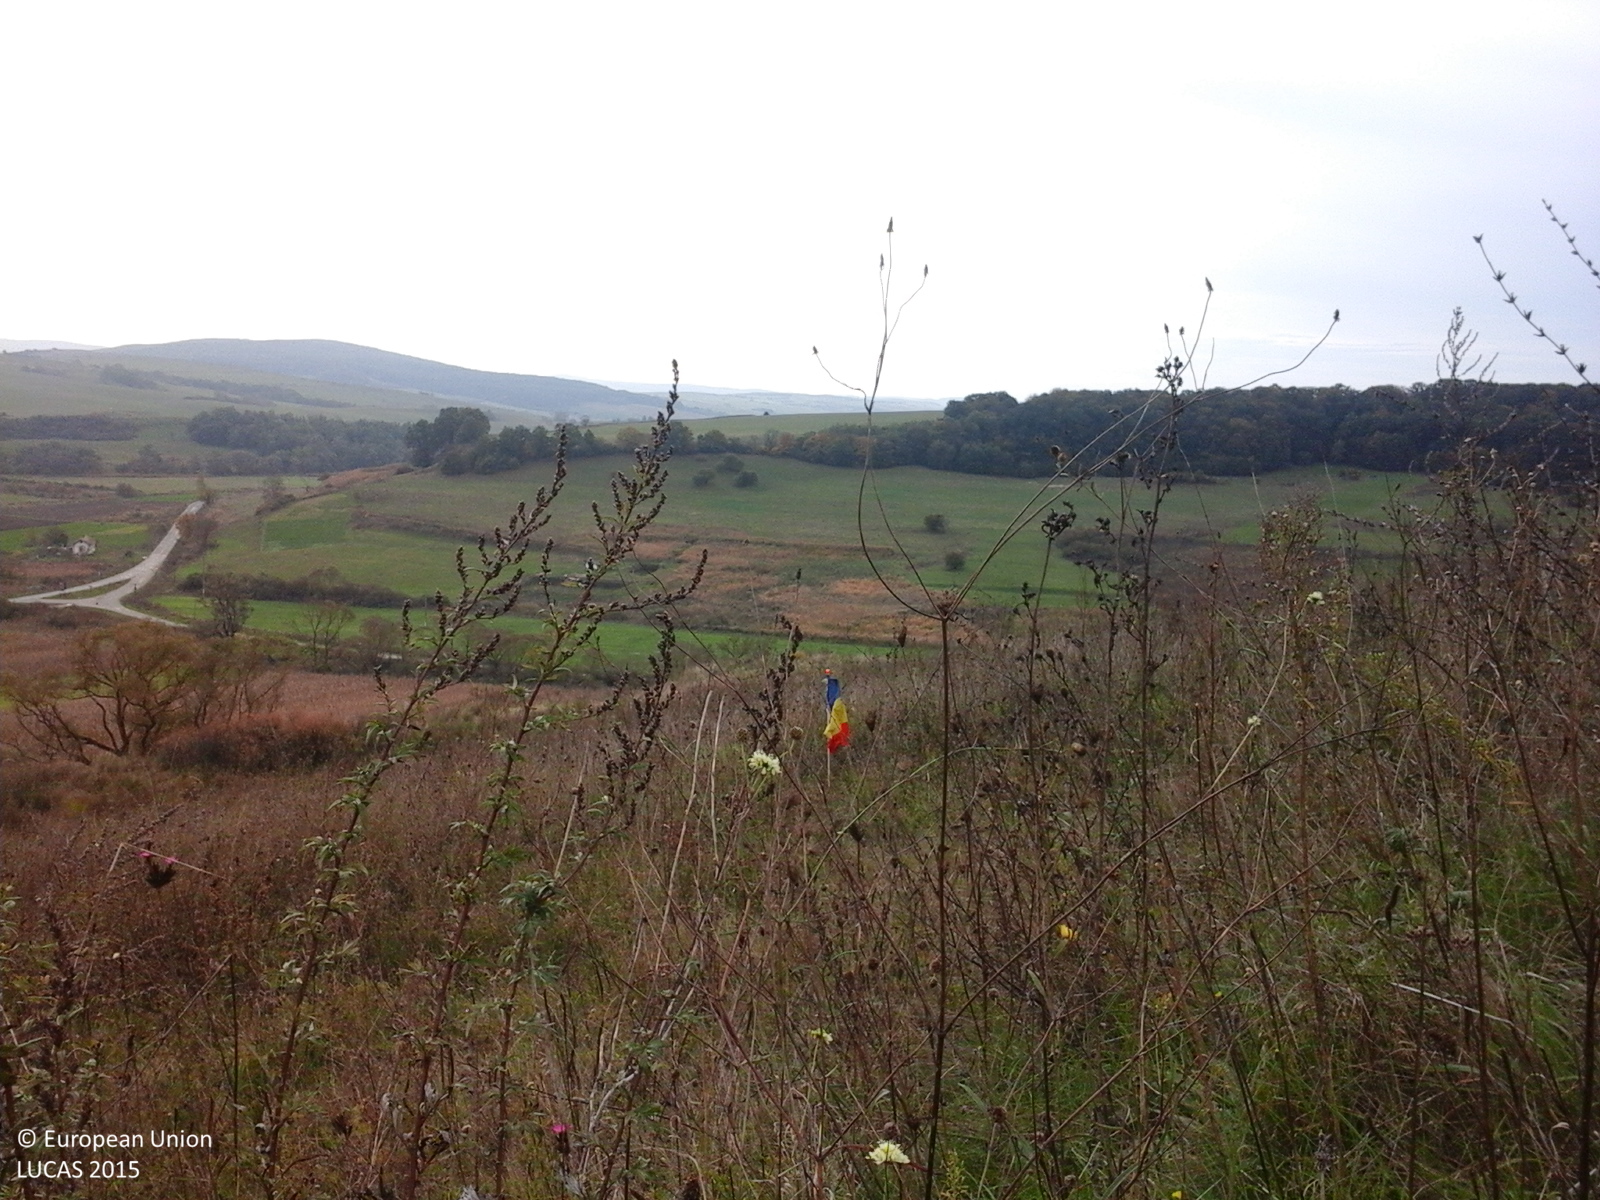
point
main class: Grassland
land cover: Spontaneously vegetated surfaces
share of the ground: > 75 %
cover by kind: herbaceous plants 100 %
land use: Fallow land
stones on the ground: < 10 %
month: October
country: RO
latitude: 46.0243
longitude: 24.6978
